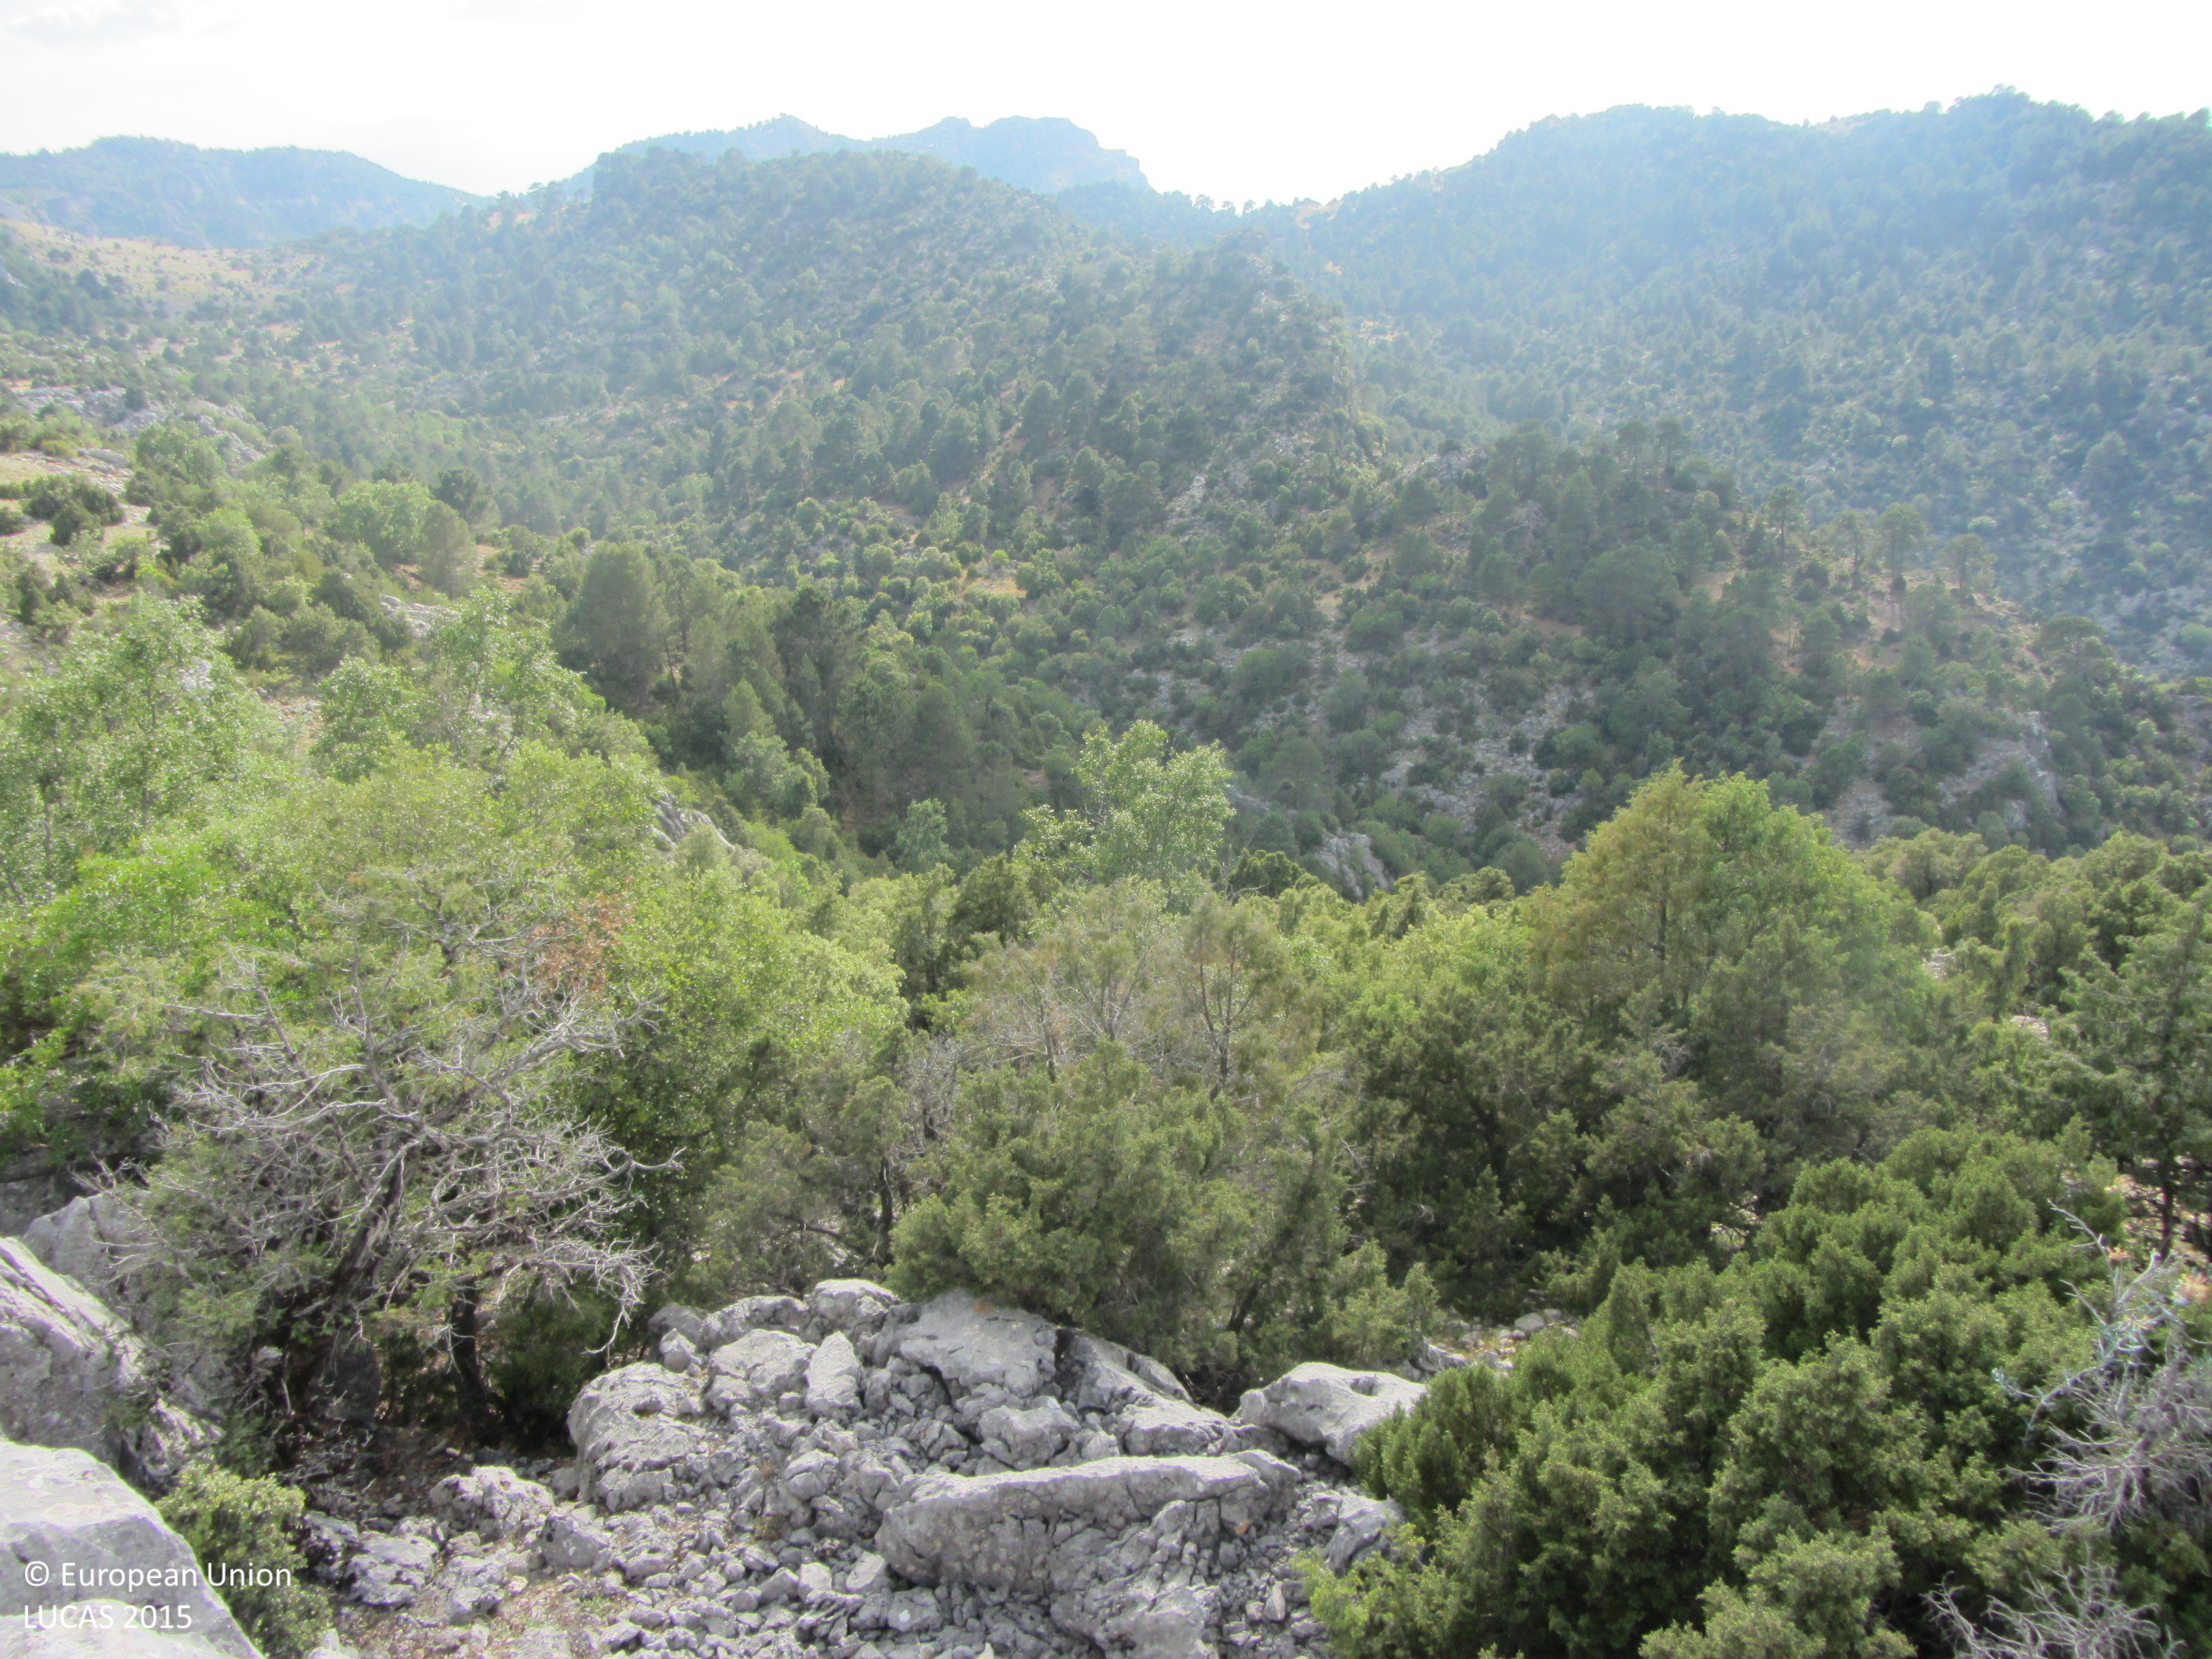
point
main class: Woodland
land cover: Pine dominated mixed woodland
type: broadleaved evergreen forest
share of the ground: 50 - 75 %
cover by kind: coniferous forest trees 40 %, broadleaved forest trees 25 %, consolidated bare surface 20 %, shrubs 15 %
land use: Semi-natural and natural areas not in use
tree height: > 5 m
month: May
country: ES
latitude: 38.0943
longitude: -2.8931
